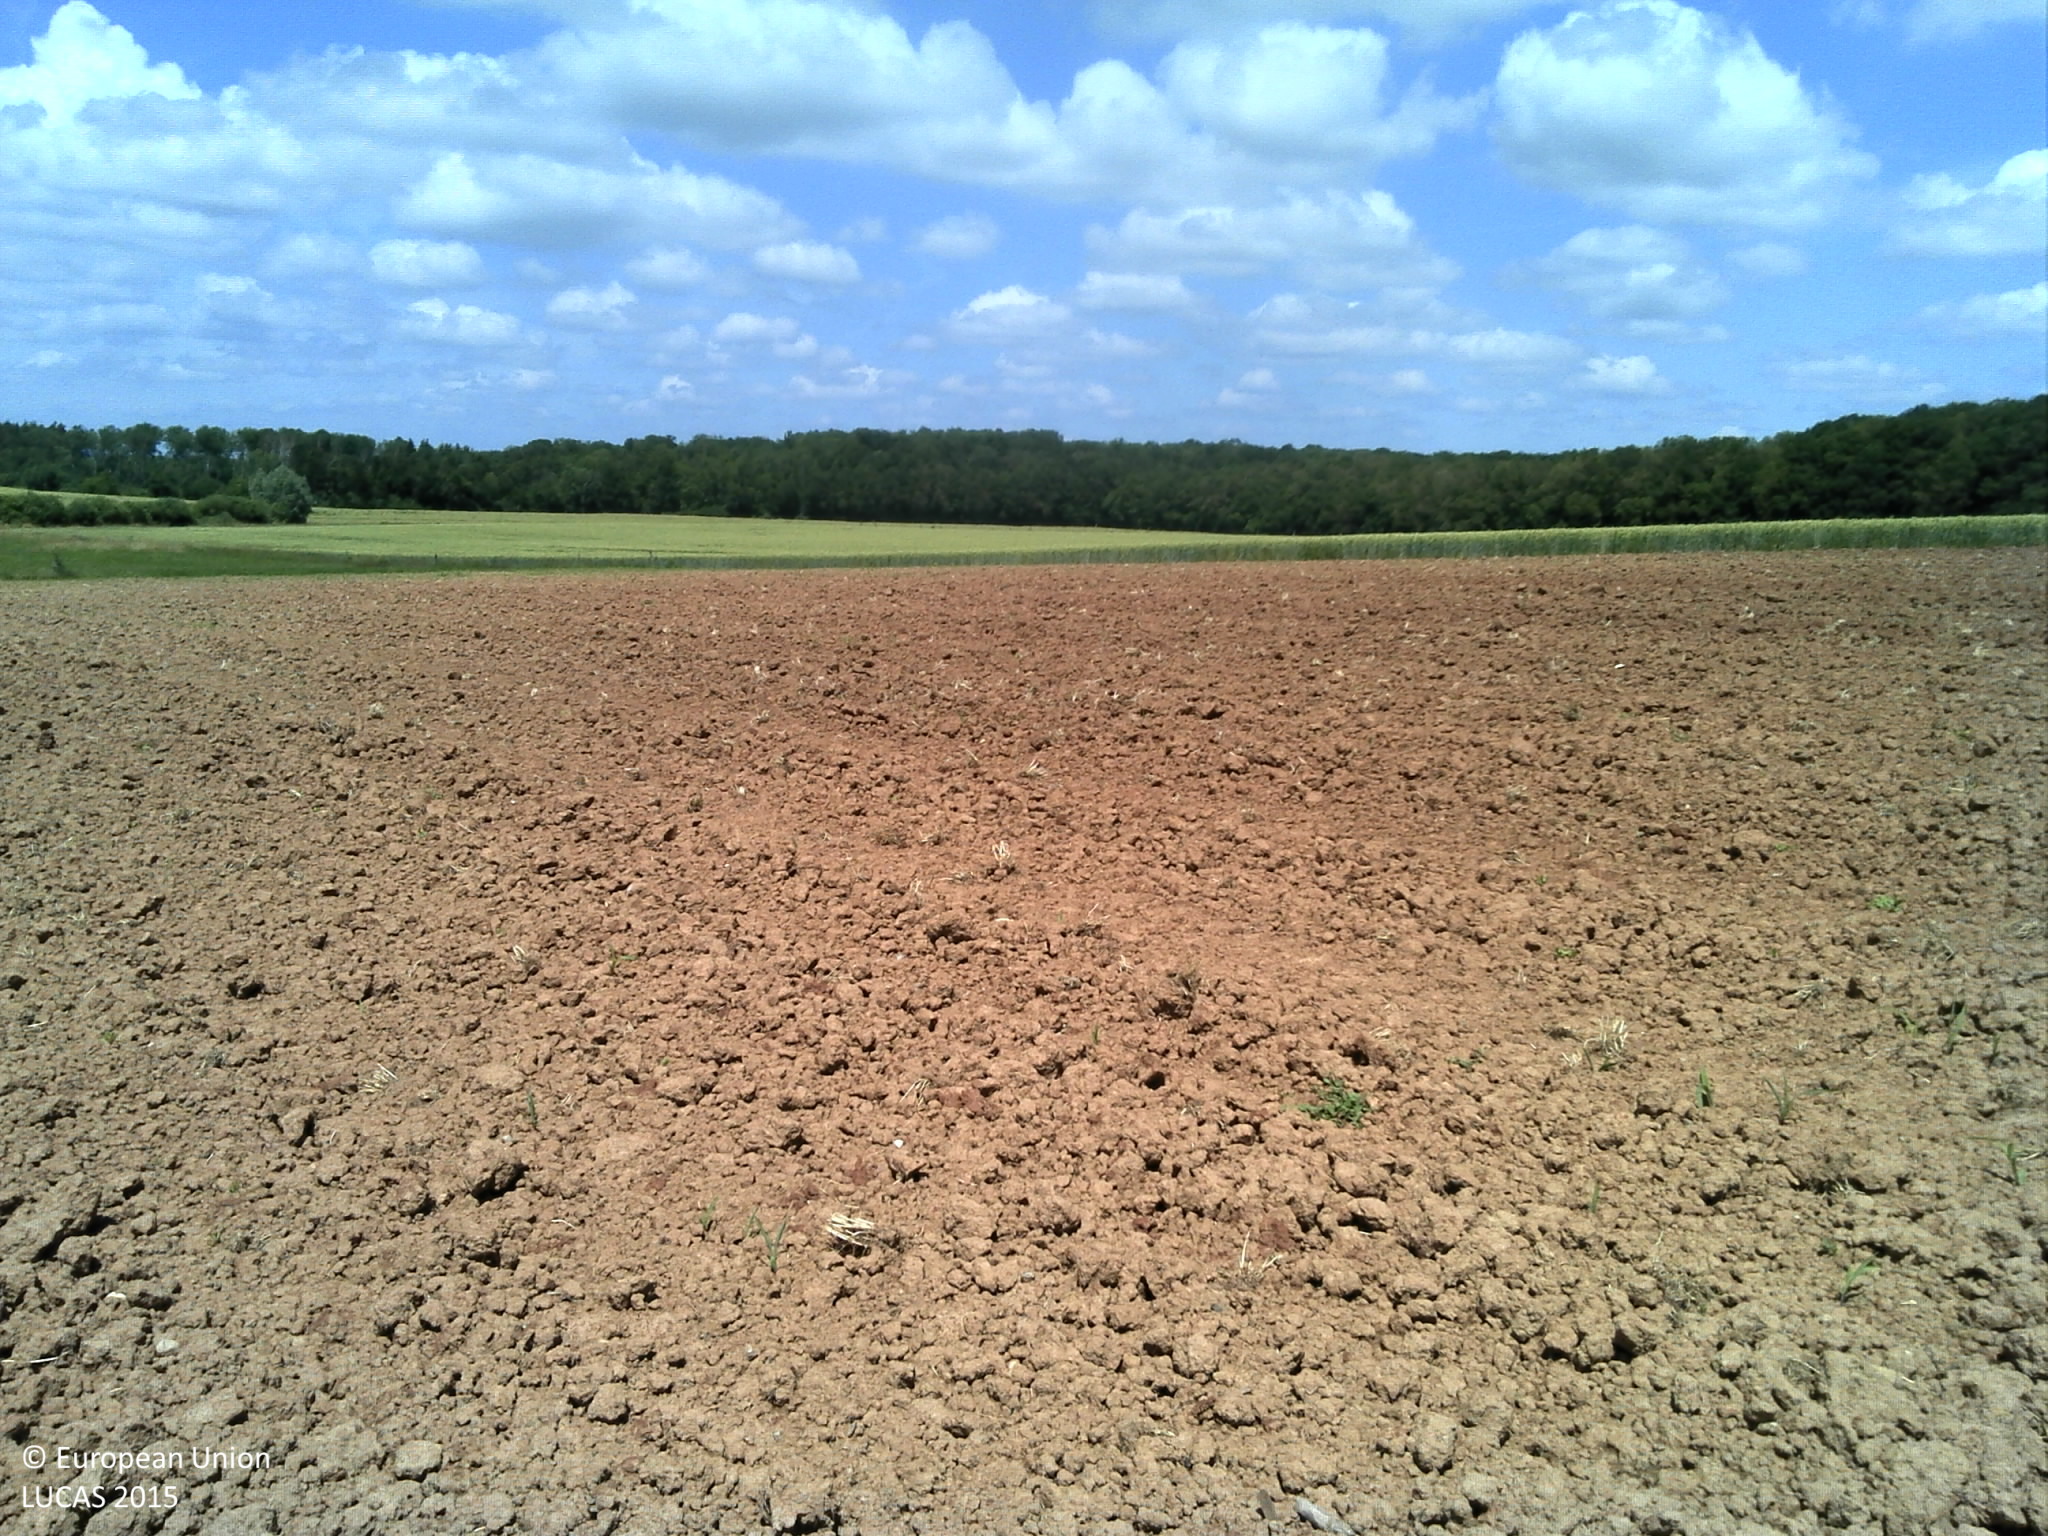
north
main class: Cropland
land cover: Maize
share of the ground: < 10 %
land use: Agriculture (excluding fallow land and kitchen gardens)
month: June
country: FR
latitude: 48.9863
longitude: 6.7617
